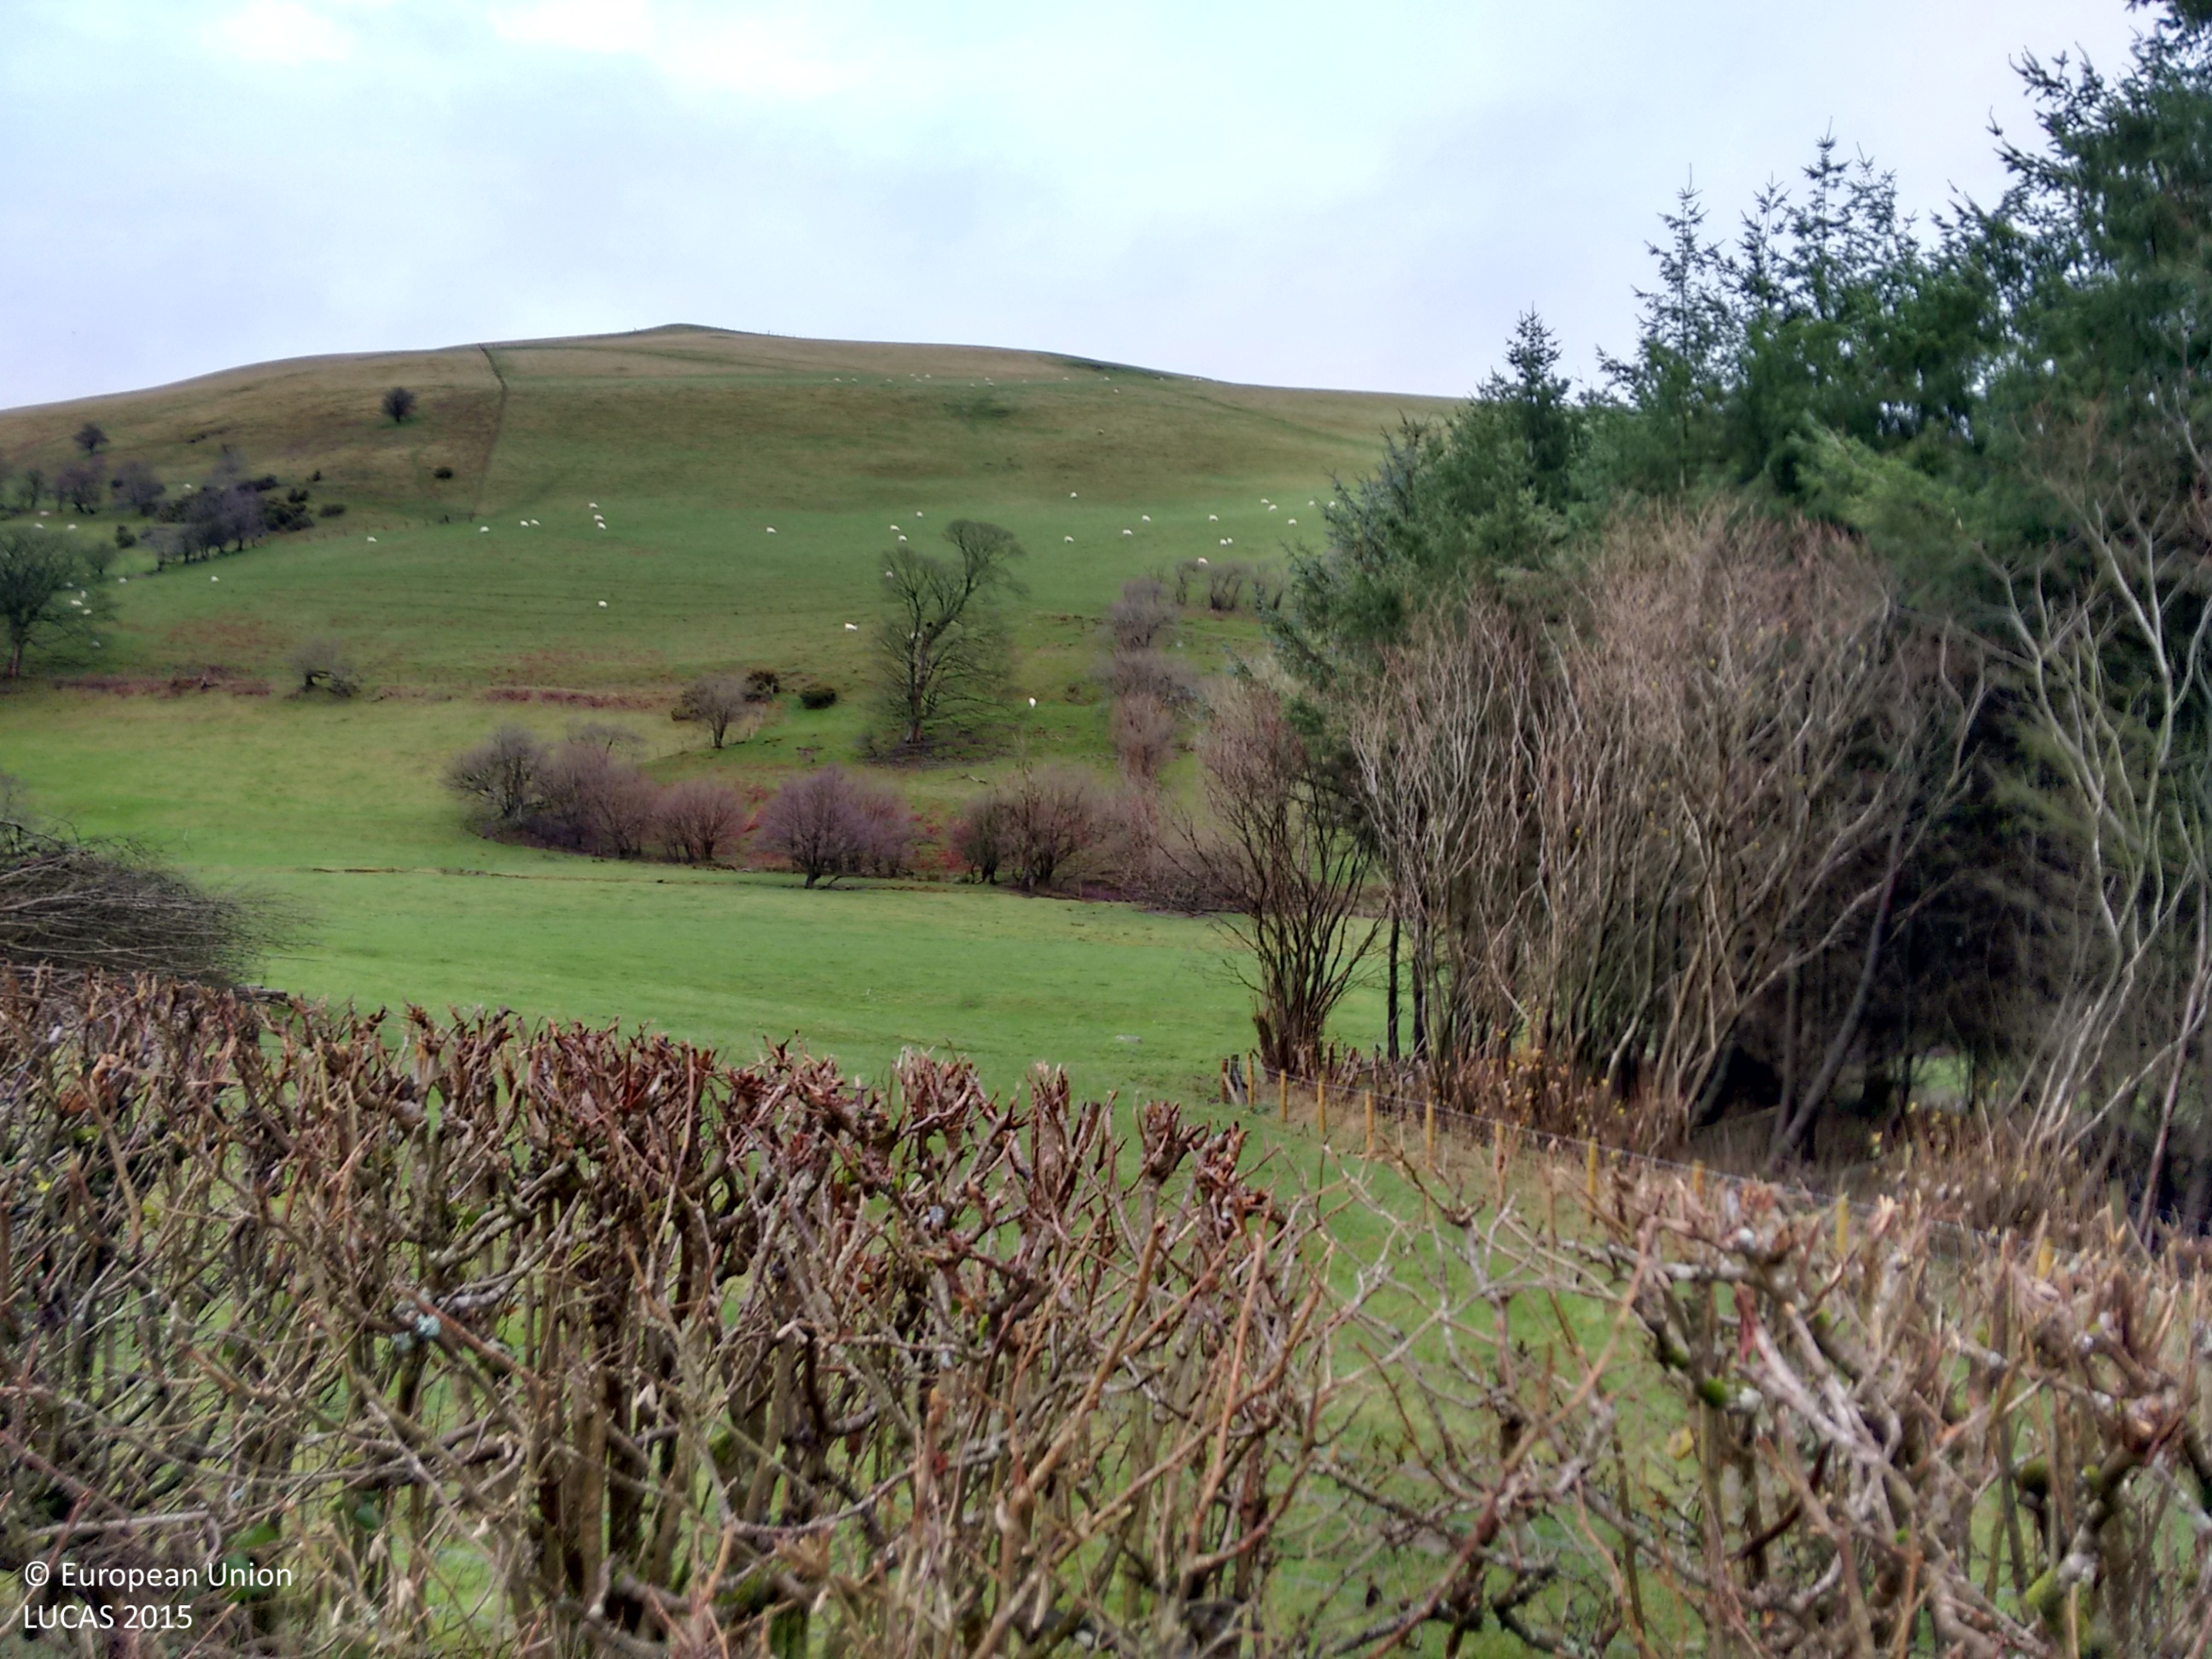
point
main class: Grassland
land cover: Grassland without tree/shrub cover
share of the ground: > 75 %
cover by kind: herbaceous plants 100 %
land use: Agriculture (excluding fallow land and kitchen gardens)
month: December
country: GB
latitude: 52.2185
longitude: -3.2086
